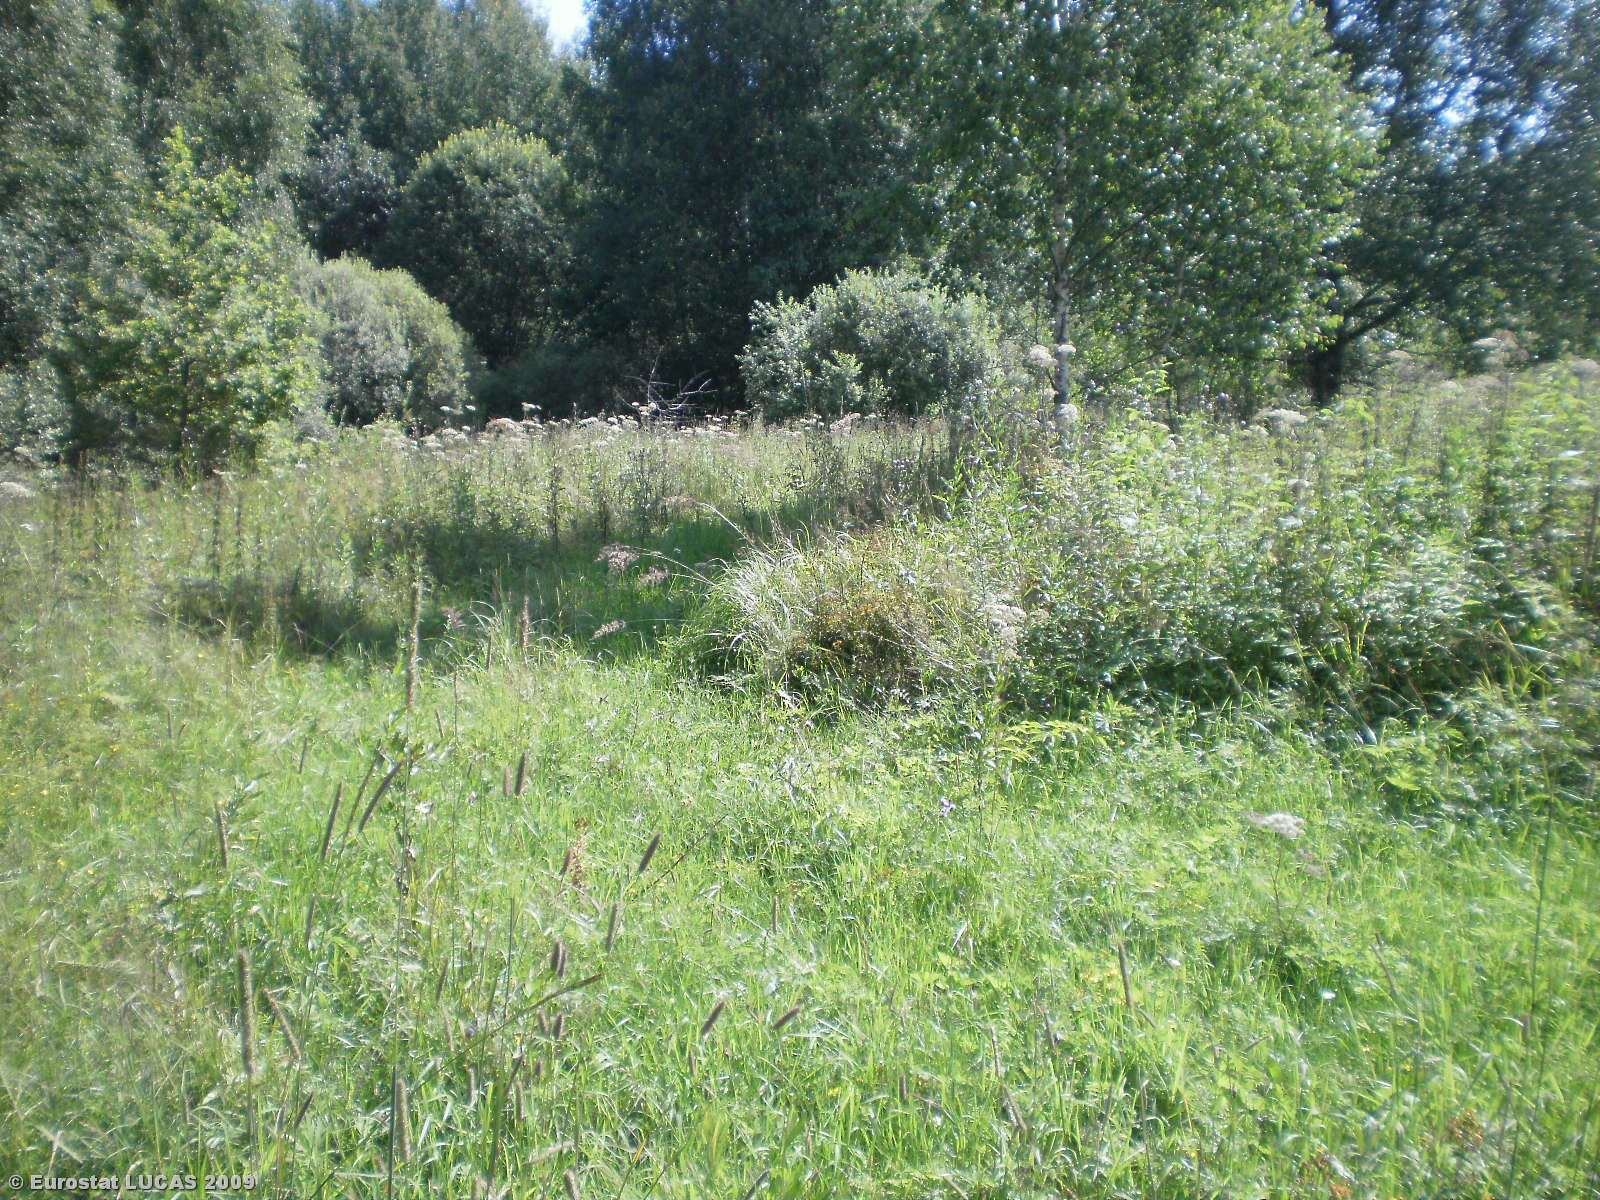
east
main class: Grassland
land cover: Grassland without tree/shrub cover
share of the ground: > 75 %
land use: Agriculture (excluding fallow land and kitchen gardens)
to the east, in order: Grassland without tree/shrub cover; Grassland with sparse tree/shrub cover; Broadleaved woodland; Coniferous woodland; Tracks; Coniferous woodland; Ditches and canals; Coniferous woodland
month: July
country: LT
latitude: 56.0584
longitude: 25.6883
